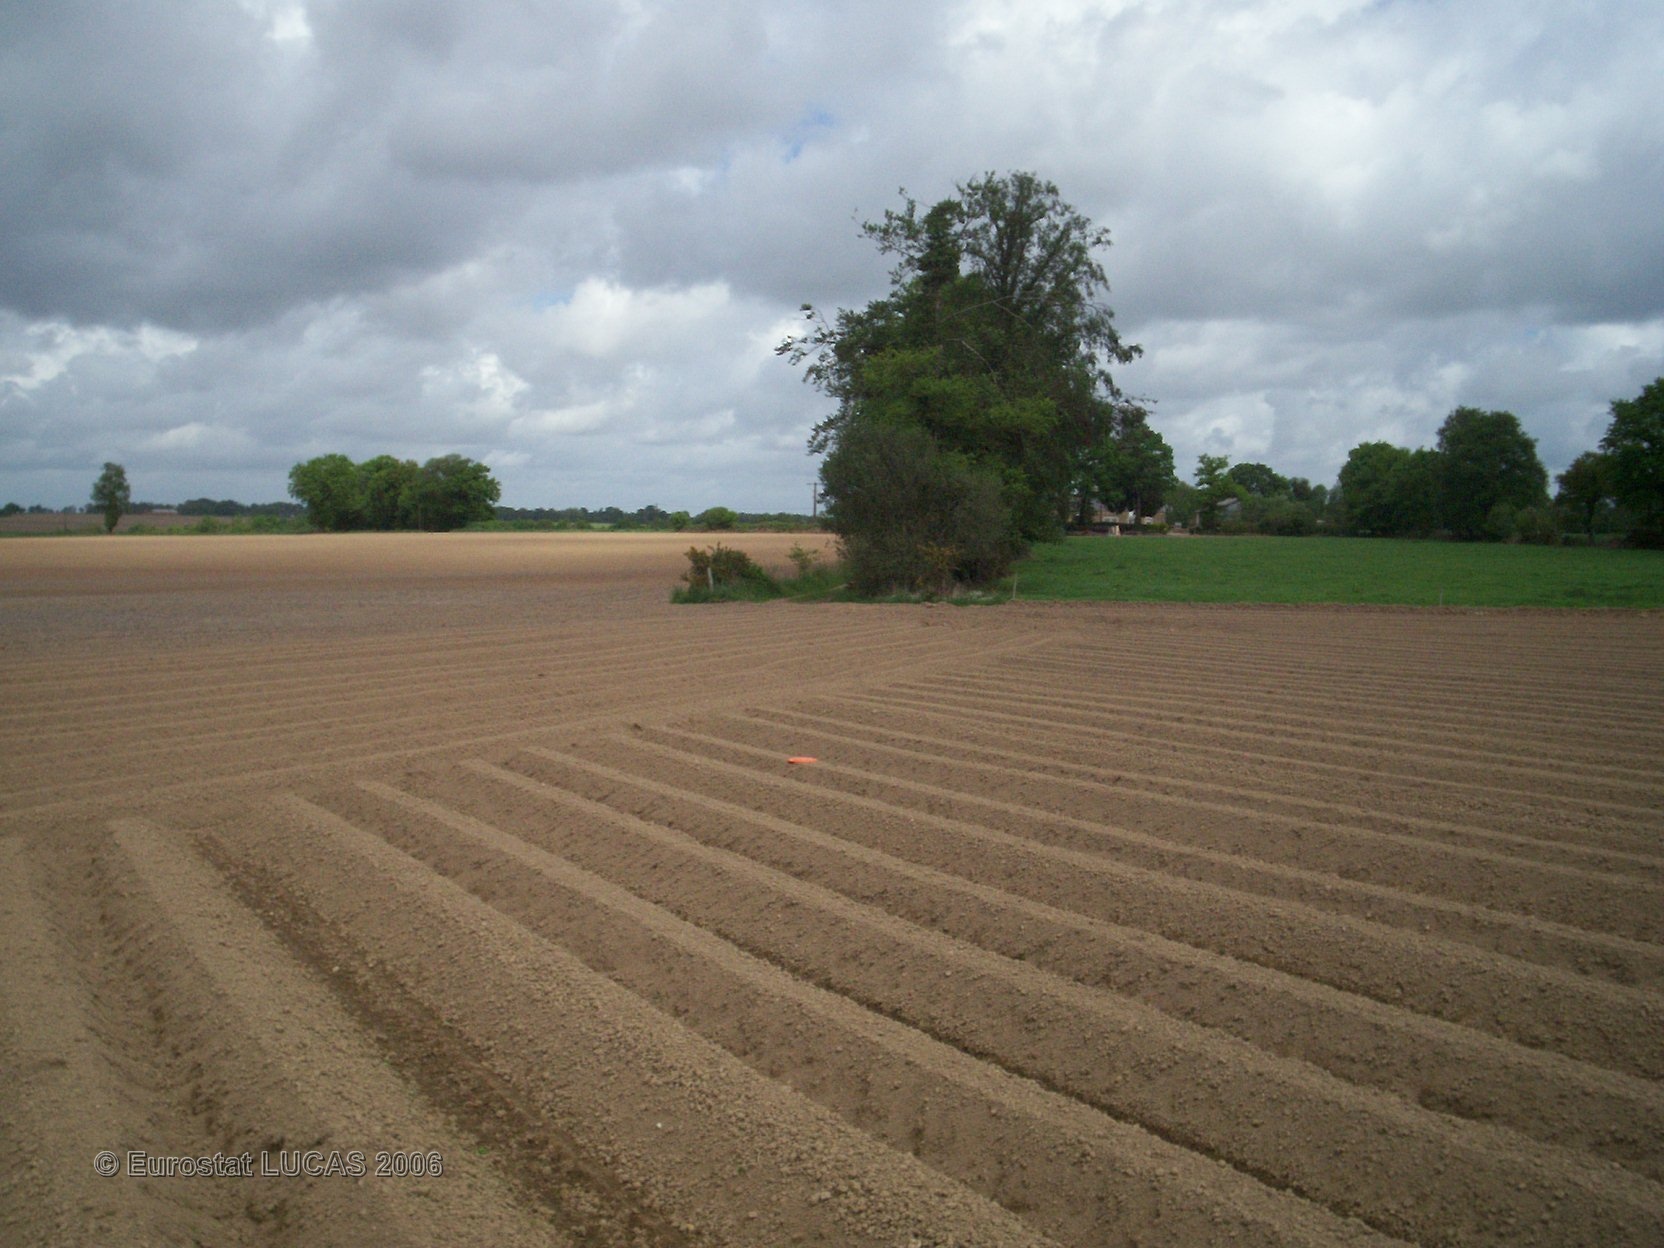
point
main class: Cropland
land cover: Potatoes
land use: Agriculture (excluding fallow land and kitchen gardens)
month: May
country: FR
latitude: 47.9892
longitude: -2.7532
